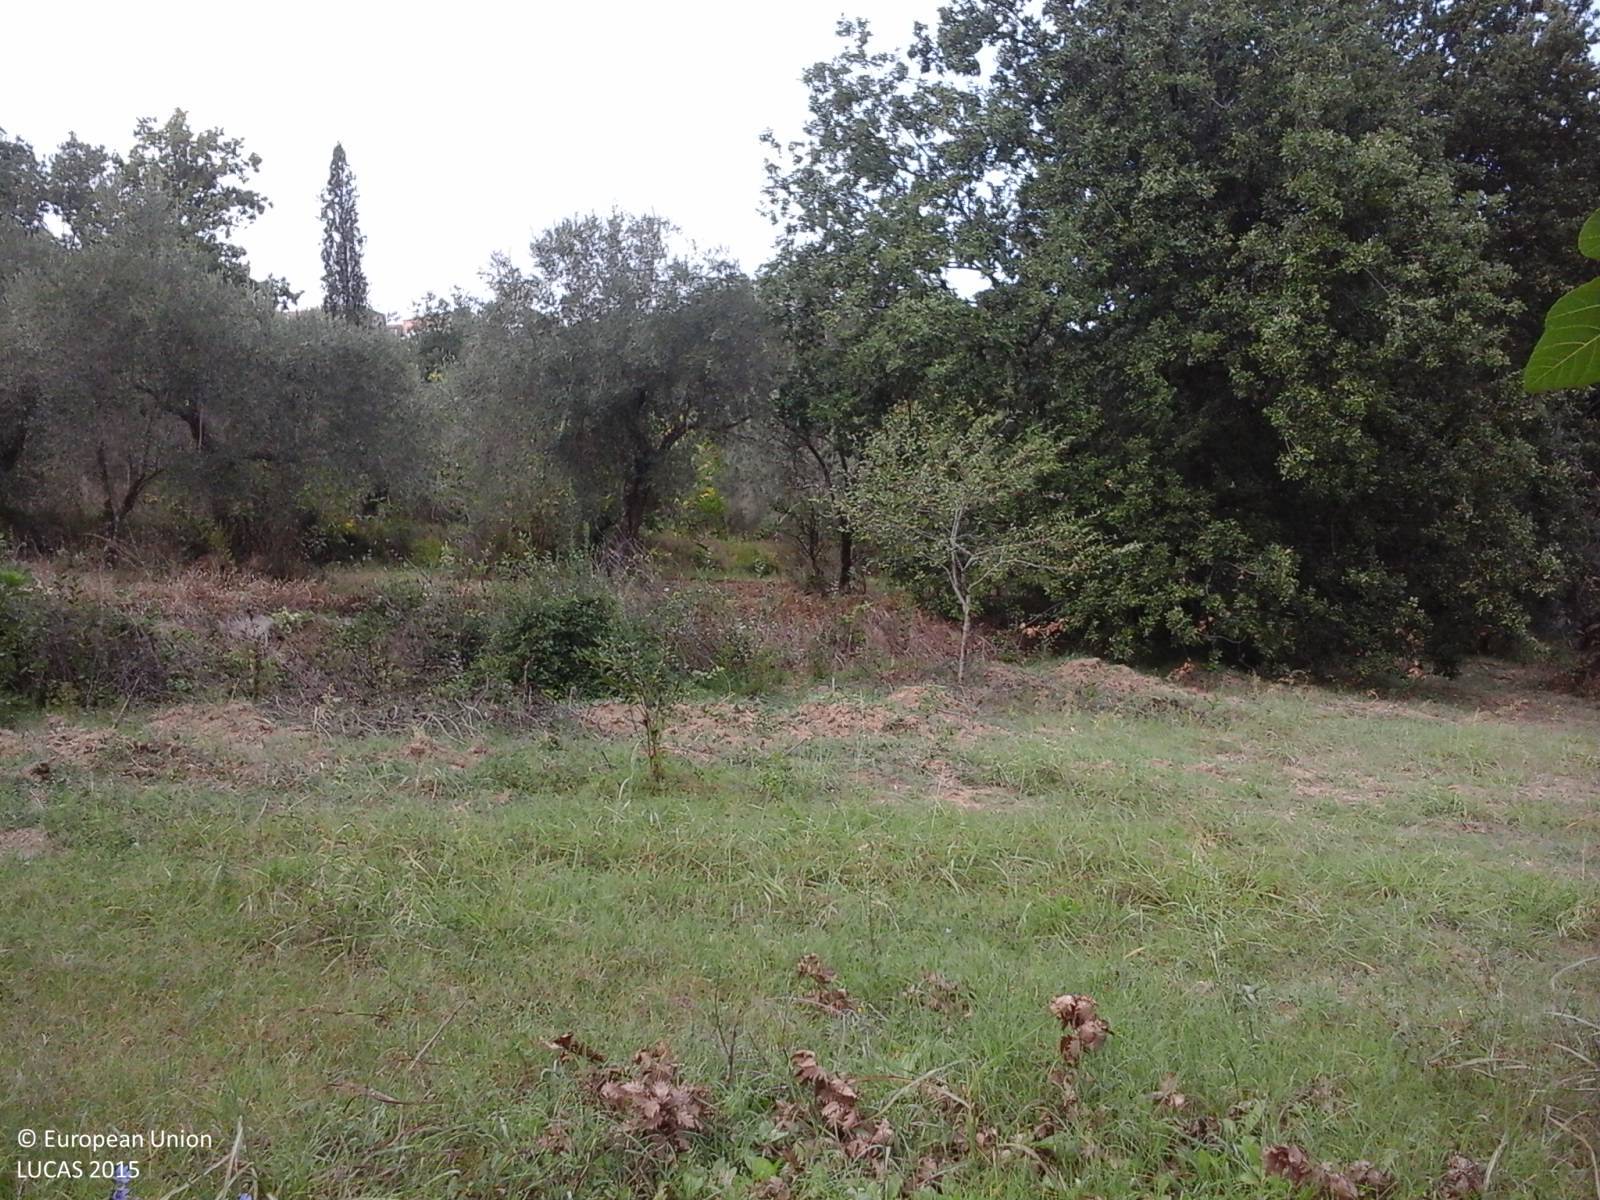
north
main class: Grassland
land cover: Spontaneously vegetated surfaces
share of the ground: > 75 %
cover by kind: herbaceous plants 100 %
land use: Agriculture (excluding fallow land and kitchen gardens)
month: September
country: IT
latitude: 41.2634
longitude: 13.7688
